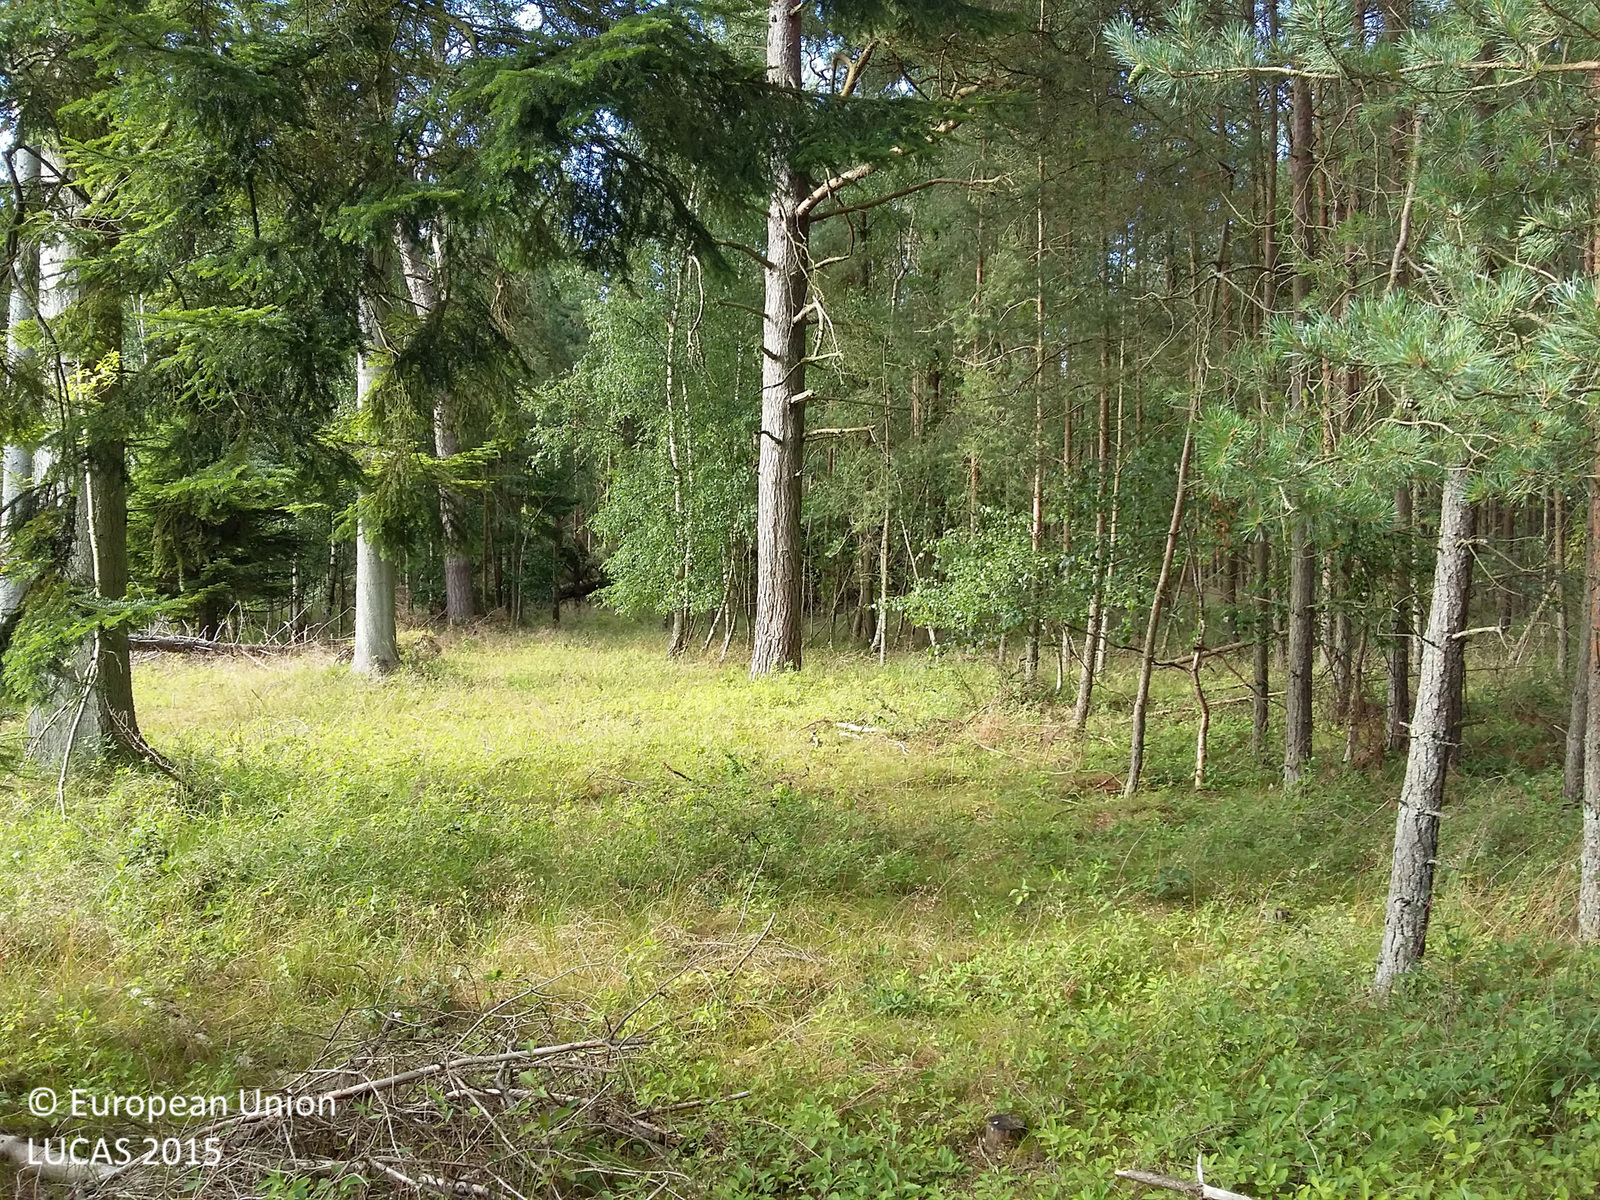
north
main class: Woodland
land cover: Pine dominated coniferous woodland
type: alpine coniferous forest
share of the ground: > 75 %
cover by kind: coniferous forest trees 70 %, herbaceous plants 20 %, broadleaved forest trees 5 %, shrubs 5 %
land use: Forestry
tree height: > 5 m
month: July
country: DK
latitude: 55.8207
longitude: 11.3872
